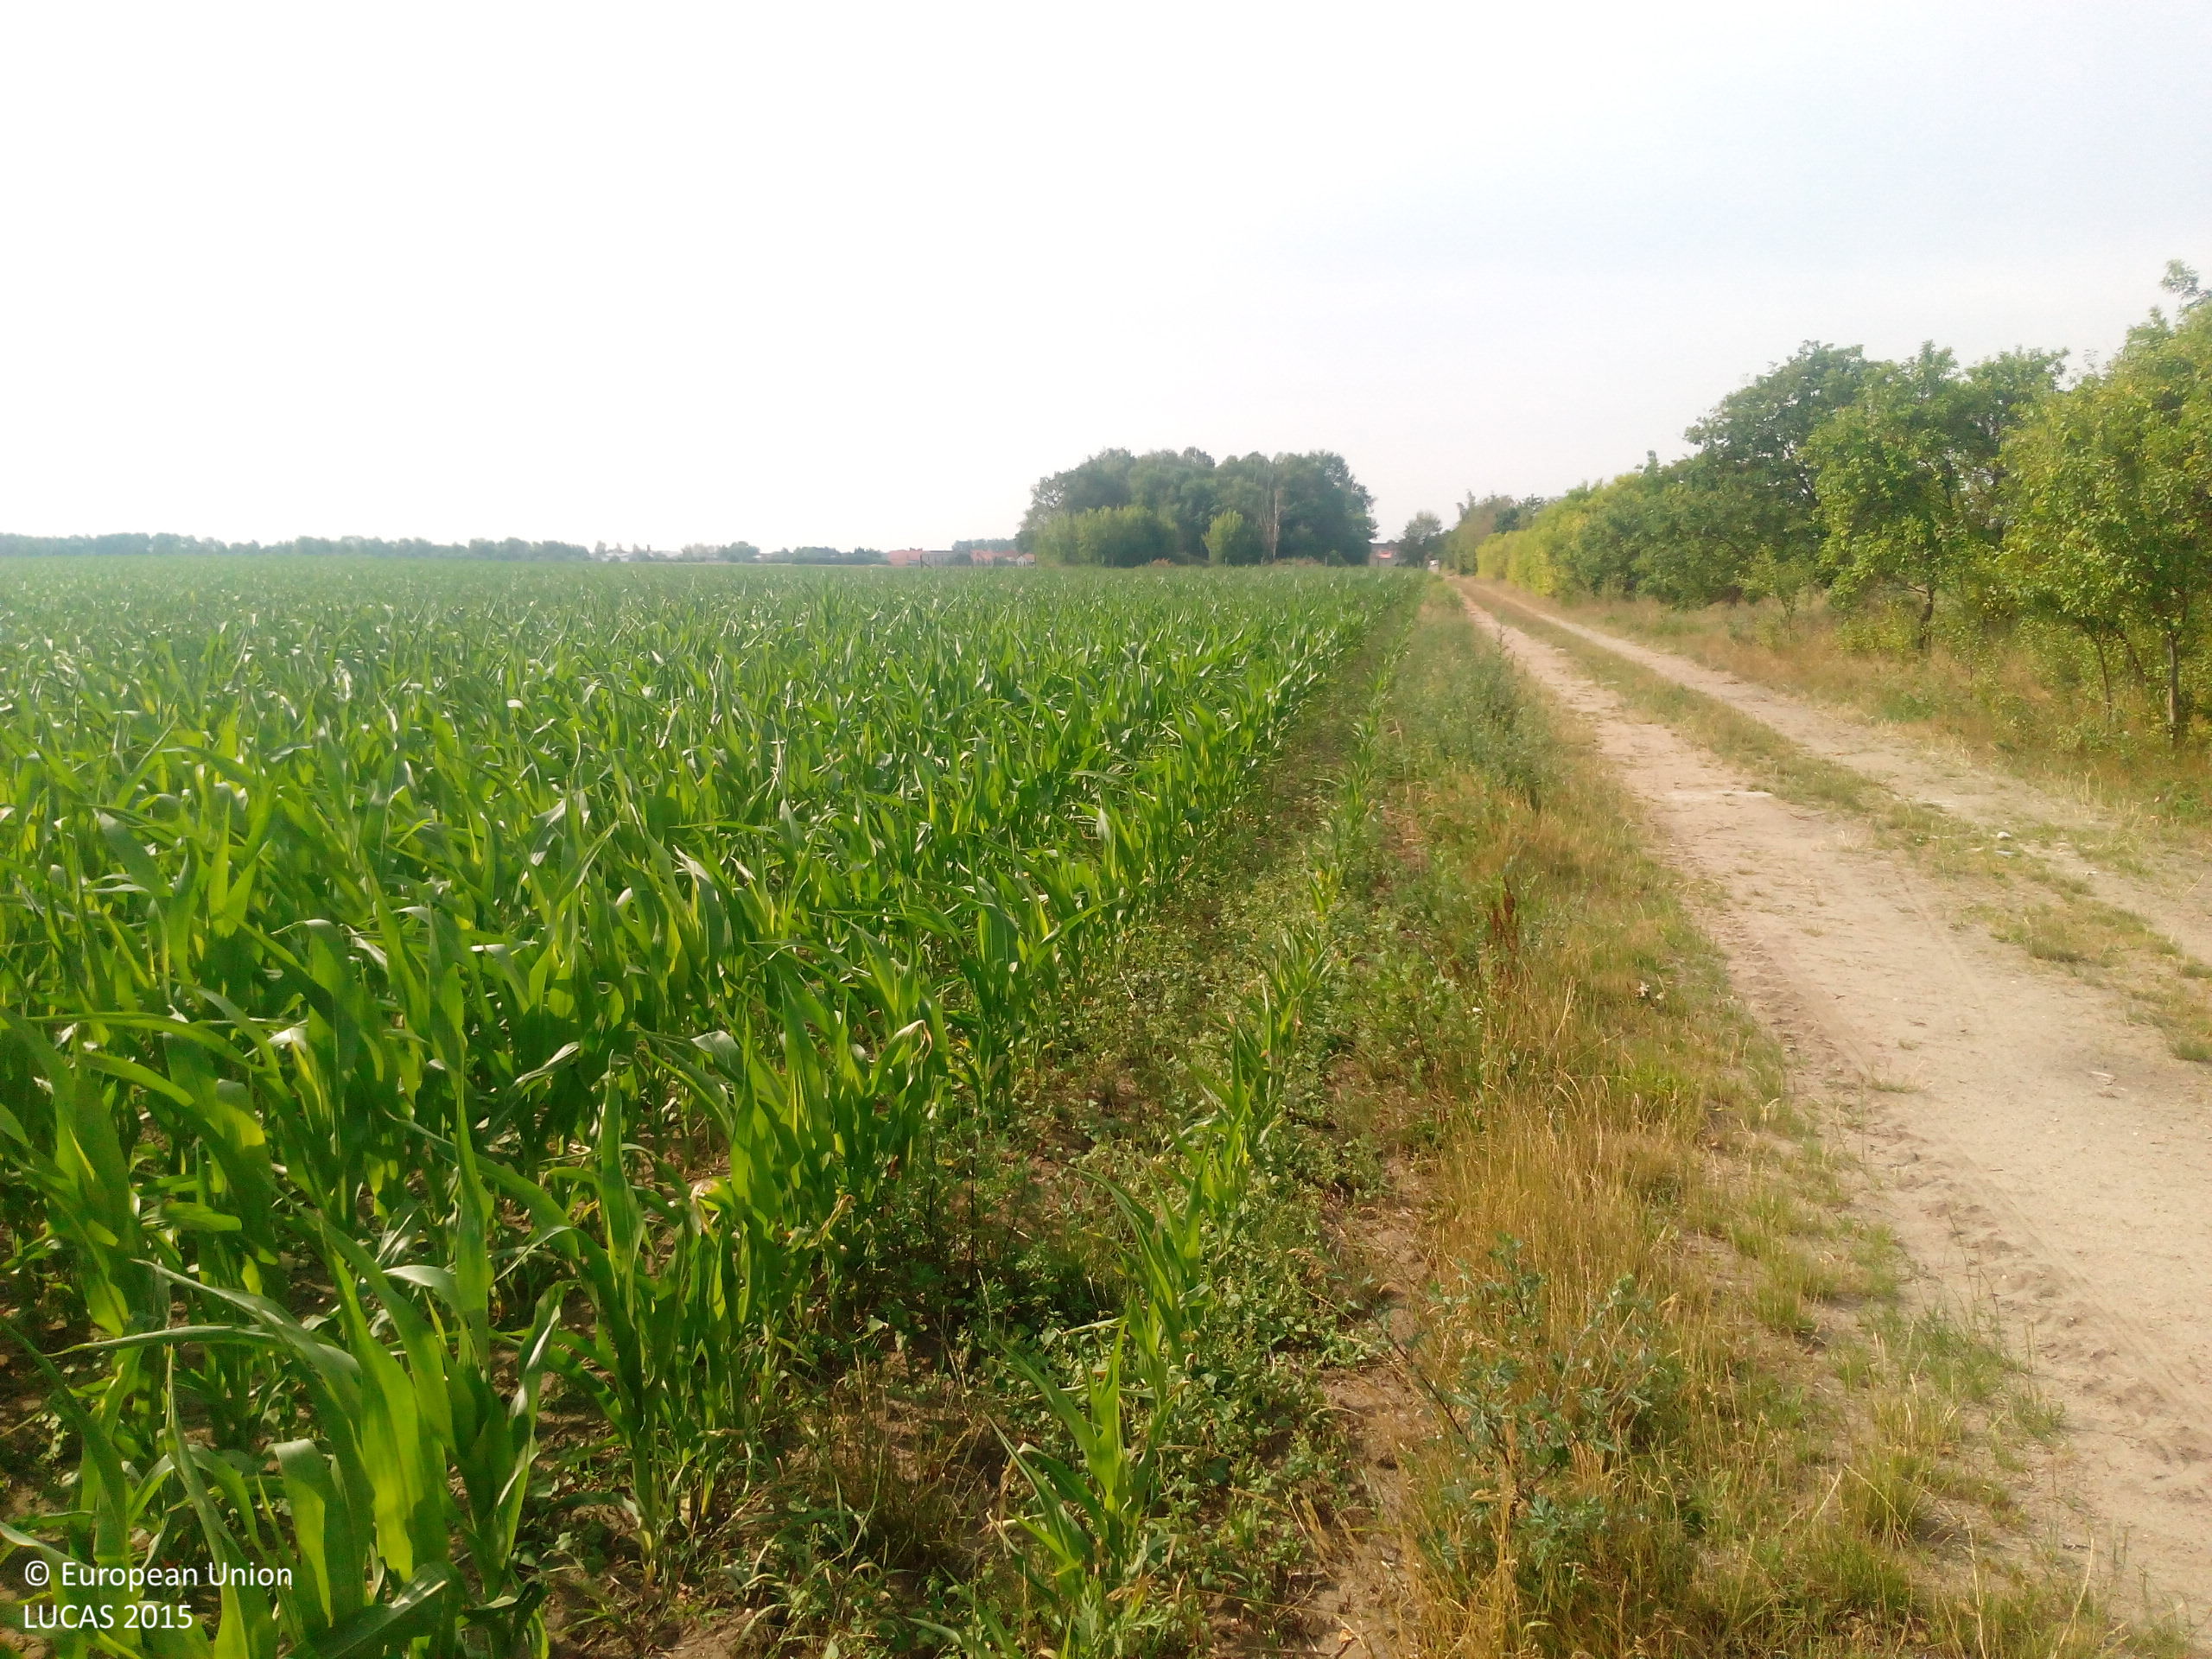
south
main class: Cropland
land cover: Maize
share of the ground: > 75 %
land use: Agriculture (excluding fallow land and kitchen gardens)
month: July
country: DE
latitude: 52.5338
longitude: 11.1348
